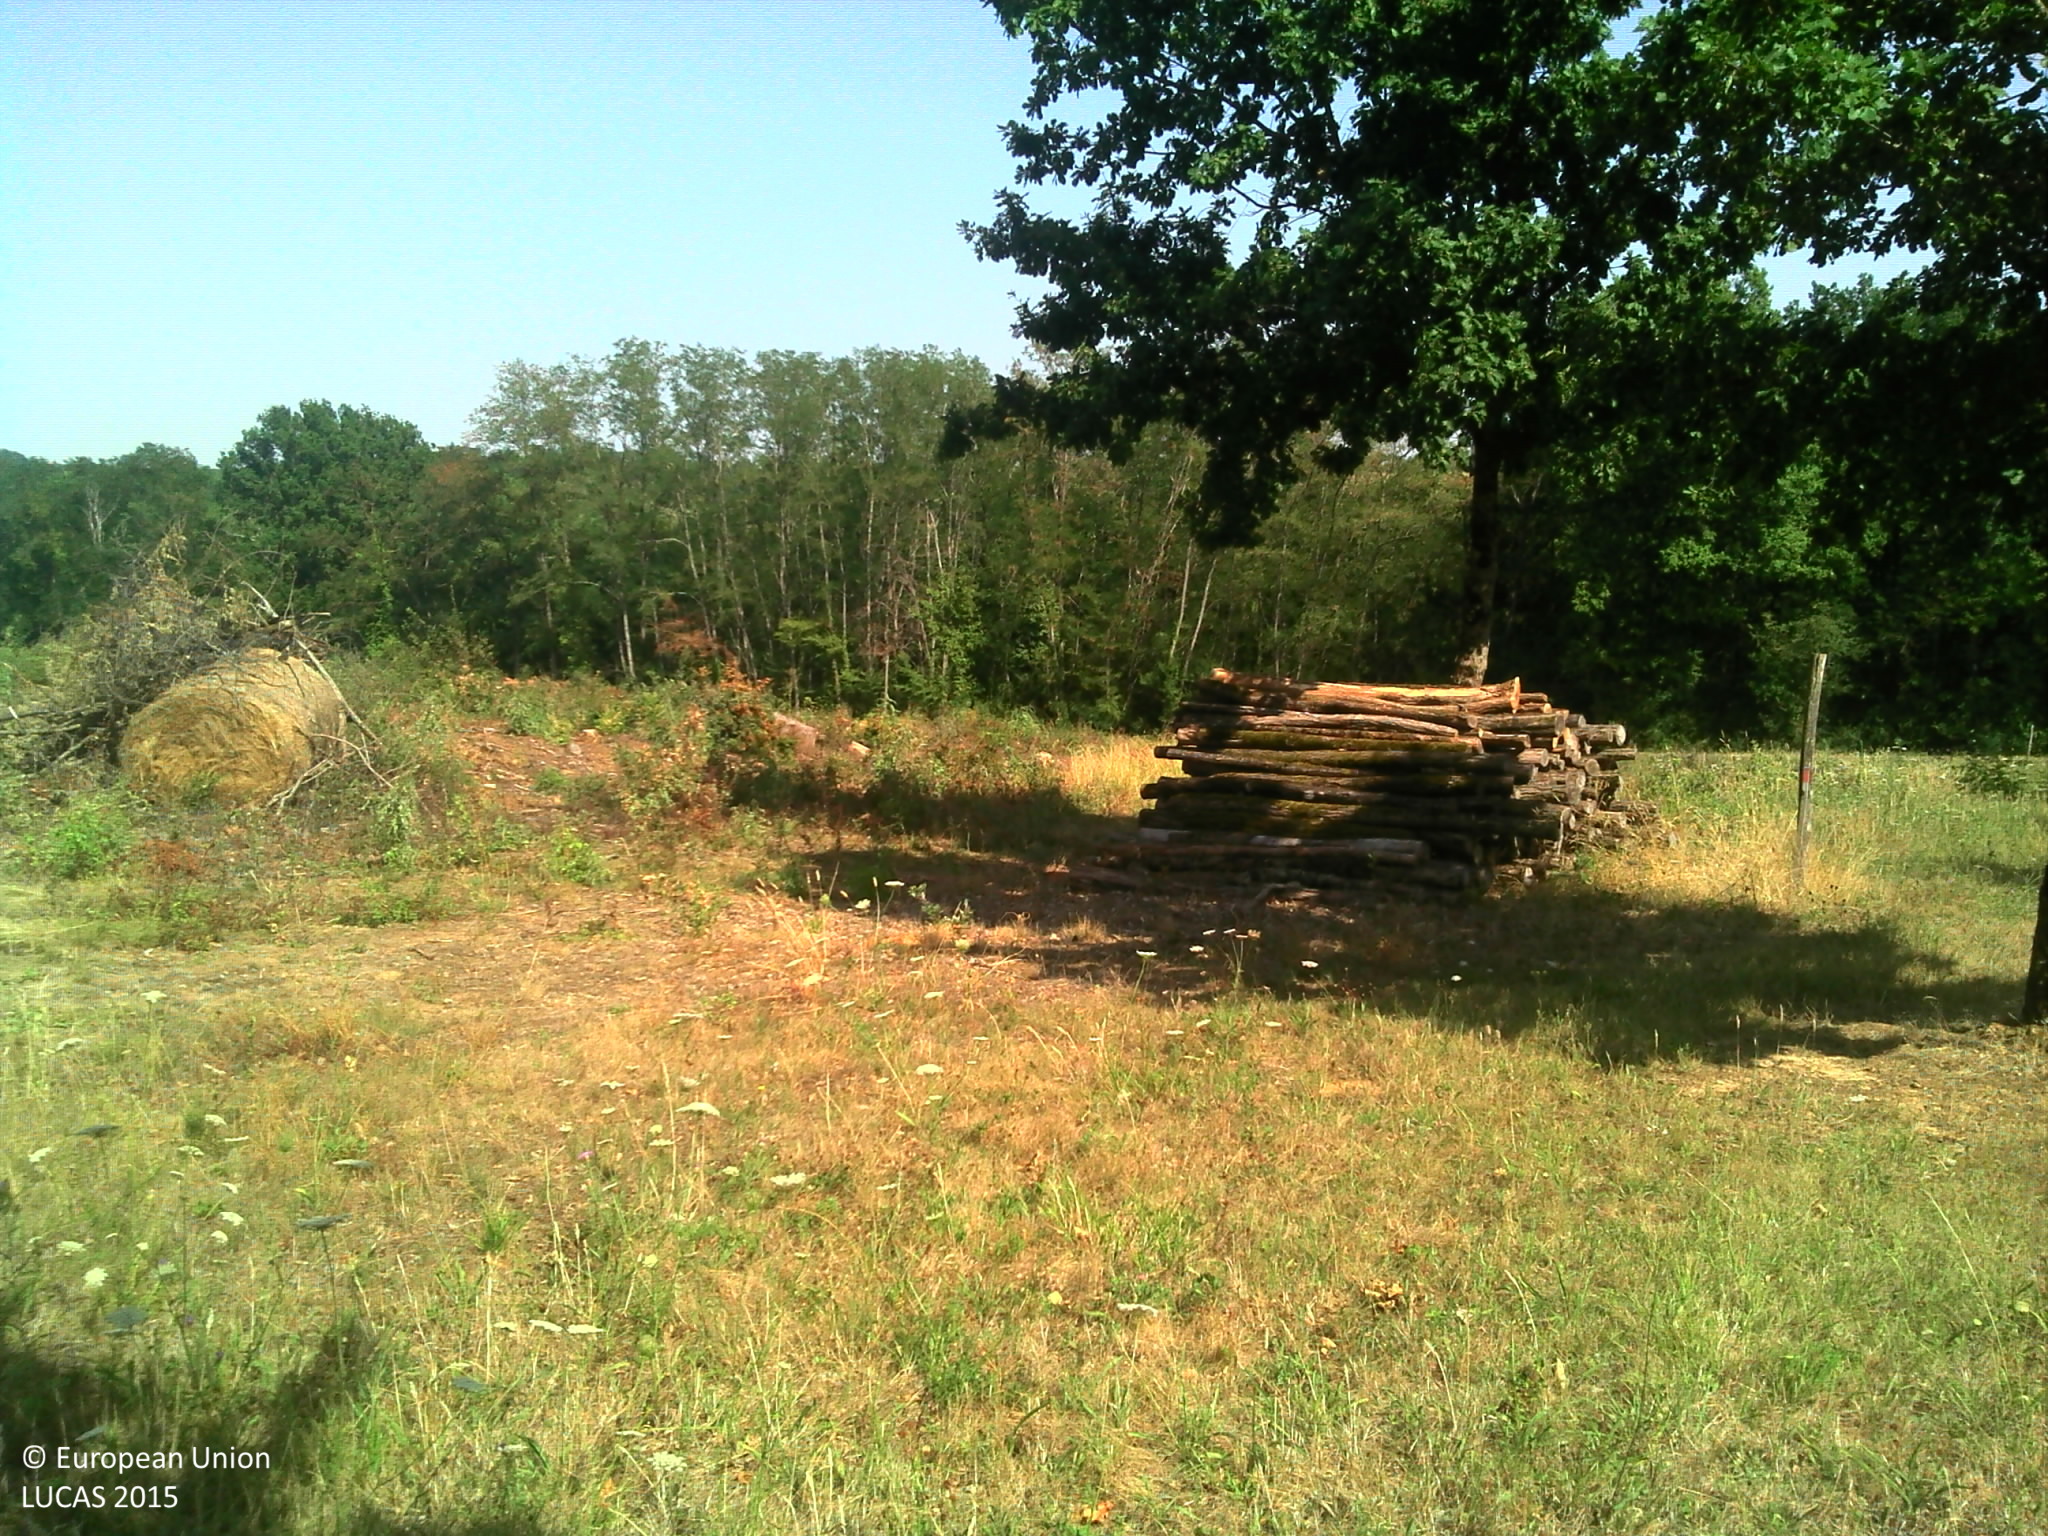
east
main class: Grassland
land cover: Grassland with sparse tree/shrub cover
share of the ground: > 75 %
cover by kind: herbaceous plants 95 %, broadleaved forest trees 5 %
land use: Agriculture (excluding fallow land and kitchen gardens)
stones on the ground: < 10 %
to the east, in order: Grassland with sparse tree/shrub cover; Broadleaved woodland; Electric lines; Ditches and canals; Paved roads, cycling and walking lanes; Grass margins; Broadleaved woodland
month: August
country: FR
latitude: 44.1507
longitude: 1.3348
